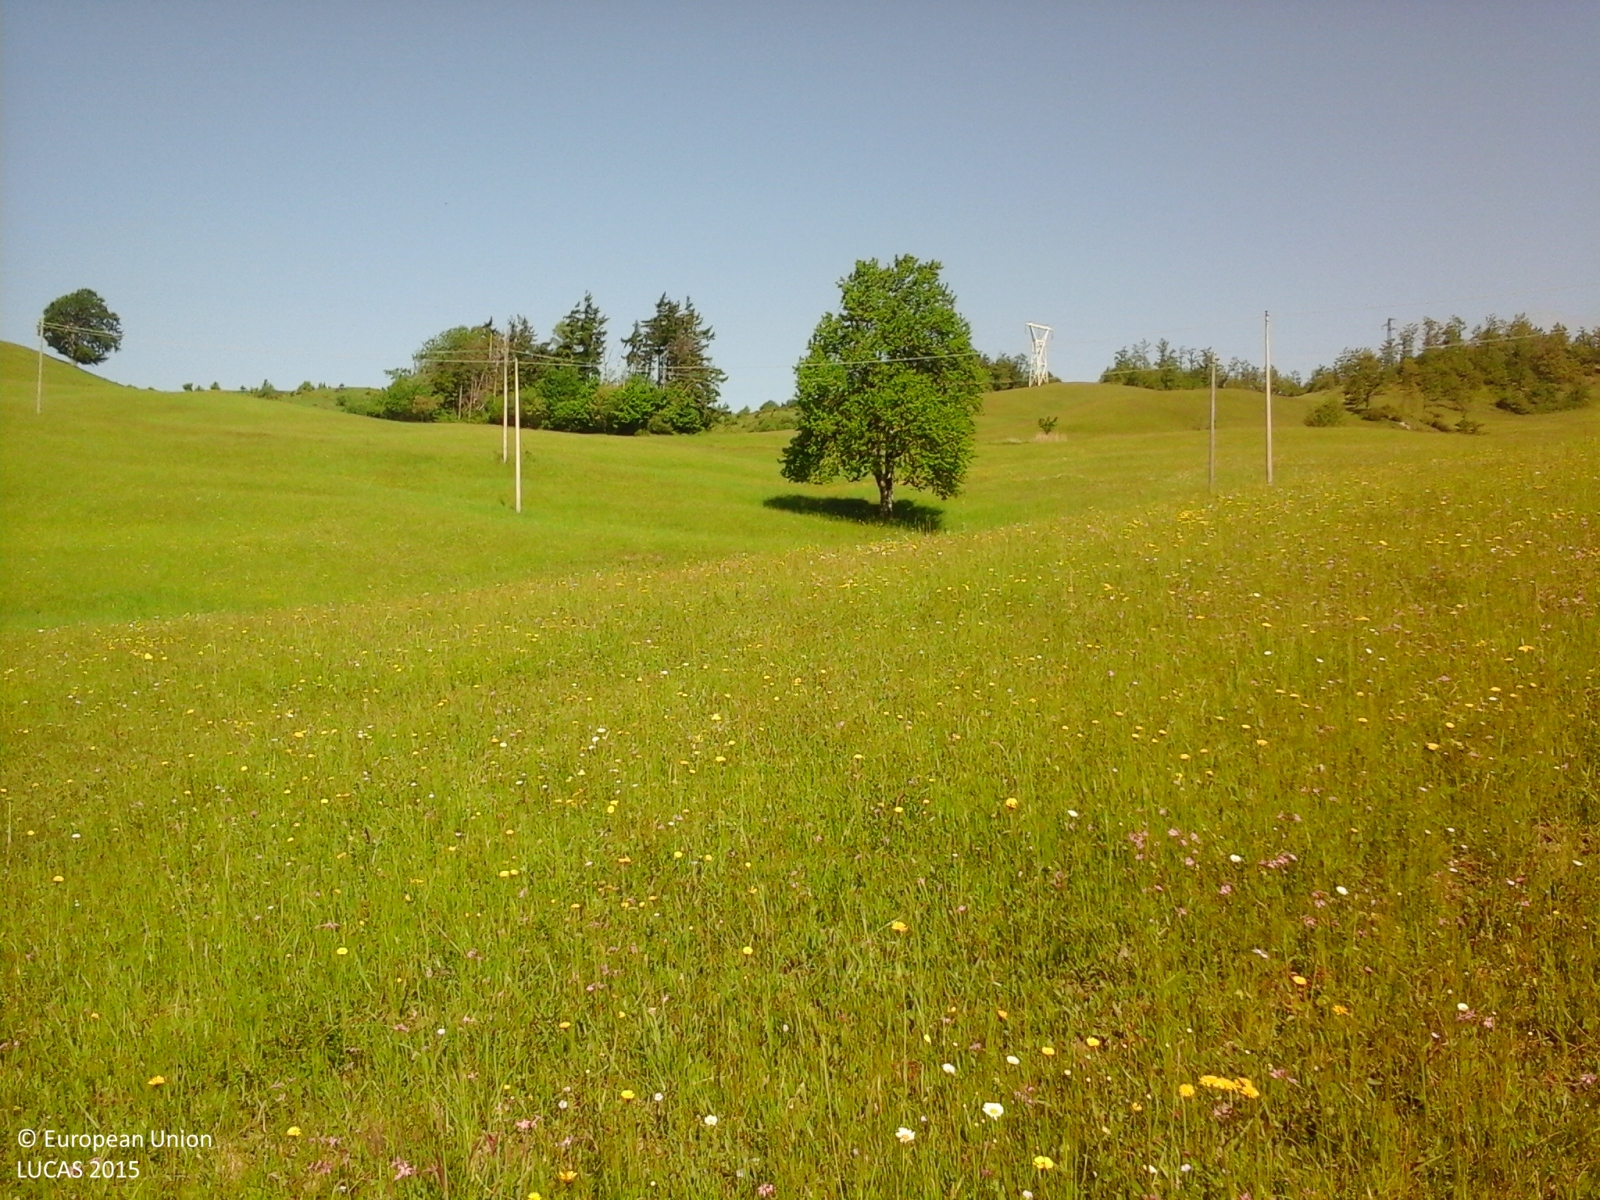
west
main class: Grassland
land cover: Grassland without tree/shrub cover
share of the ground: > 75 %
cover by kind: herbaceous plants 100 %
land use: Agriculture (excluding fallow land and kitchen gardens)
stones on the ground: < 10 %
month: May
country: IT
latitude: 44.1281
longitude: 11.1096
